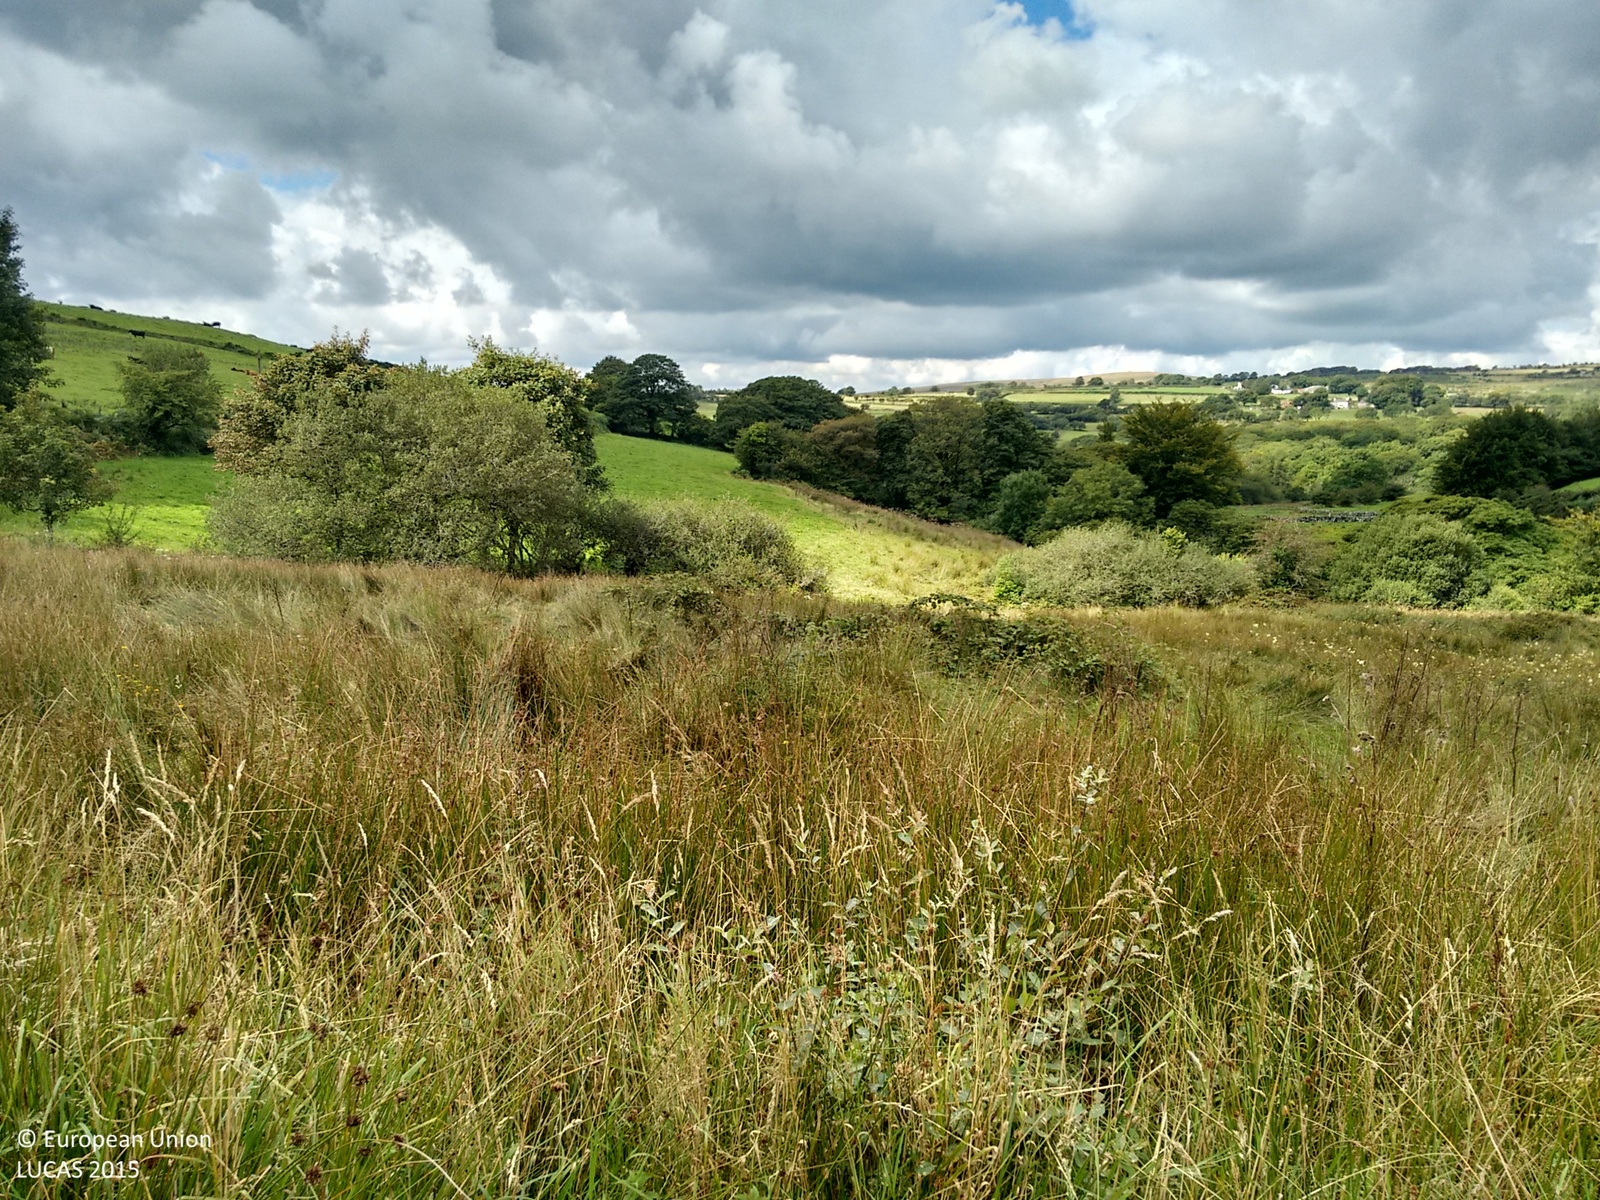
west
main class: Woodland
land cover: Broadleaved woodland
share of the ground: > 75 %
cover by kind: broadleaved forest trees 100 %
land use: Agriculture (excluding fallow land and kitchen gardens)
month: September
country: GB
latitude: 50.6026
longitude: -4.0689
